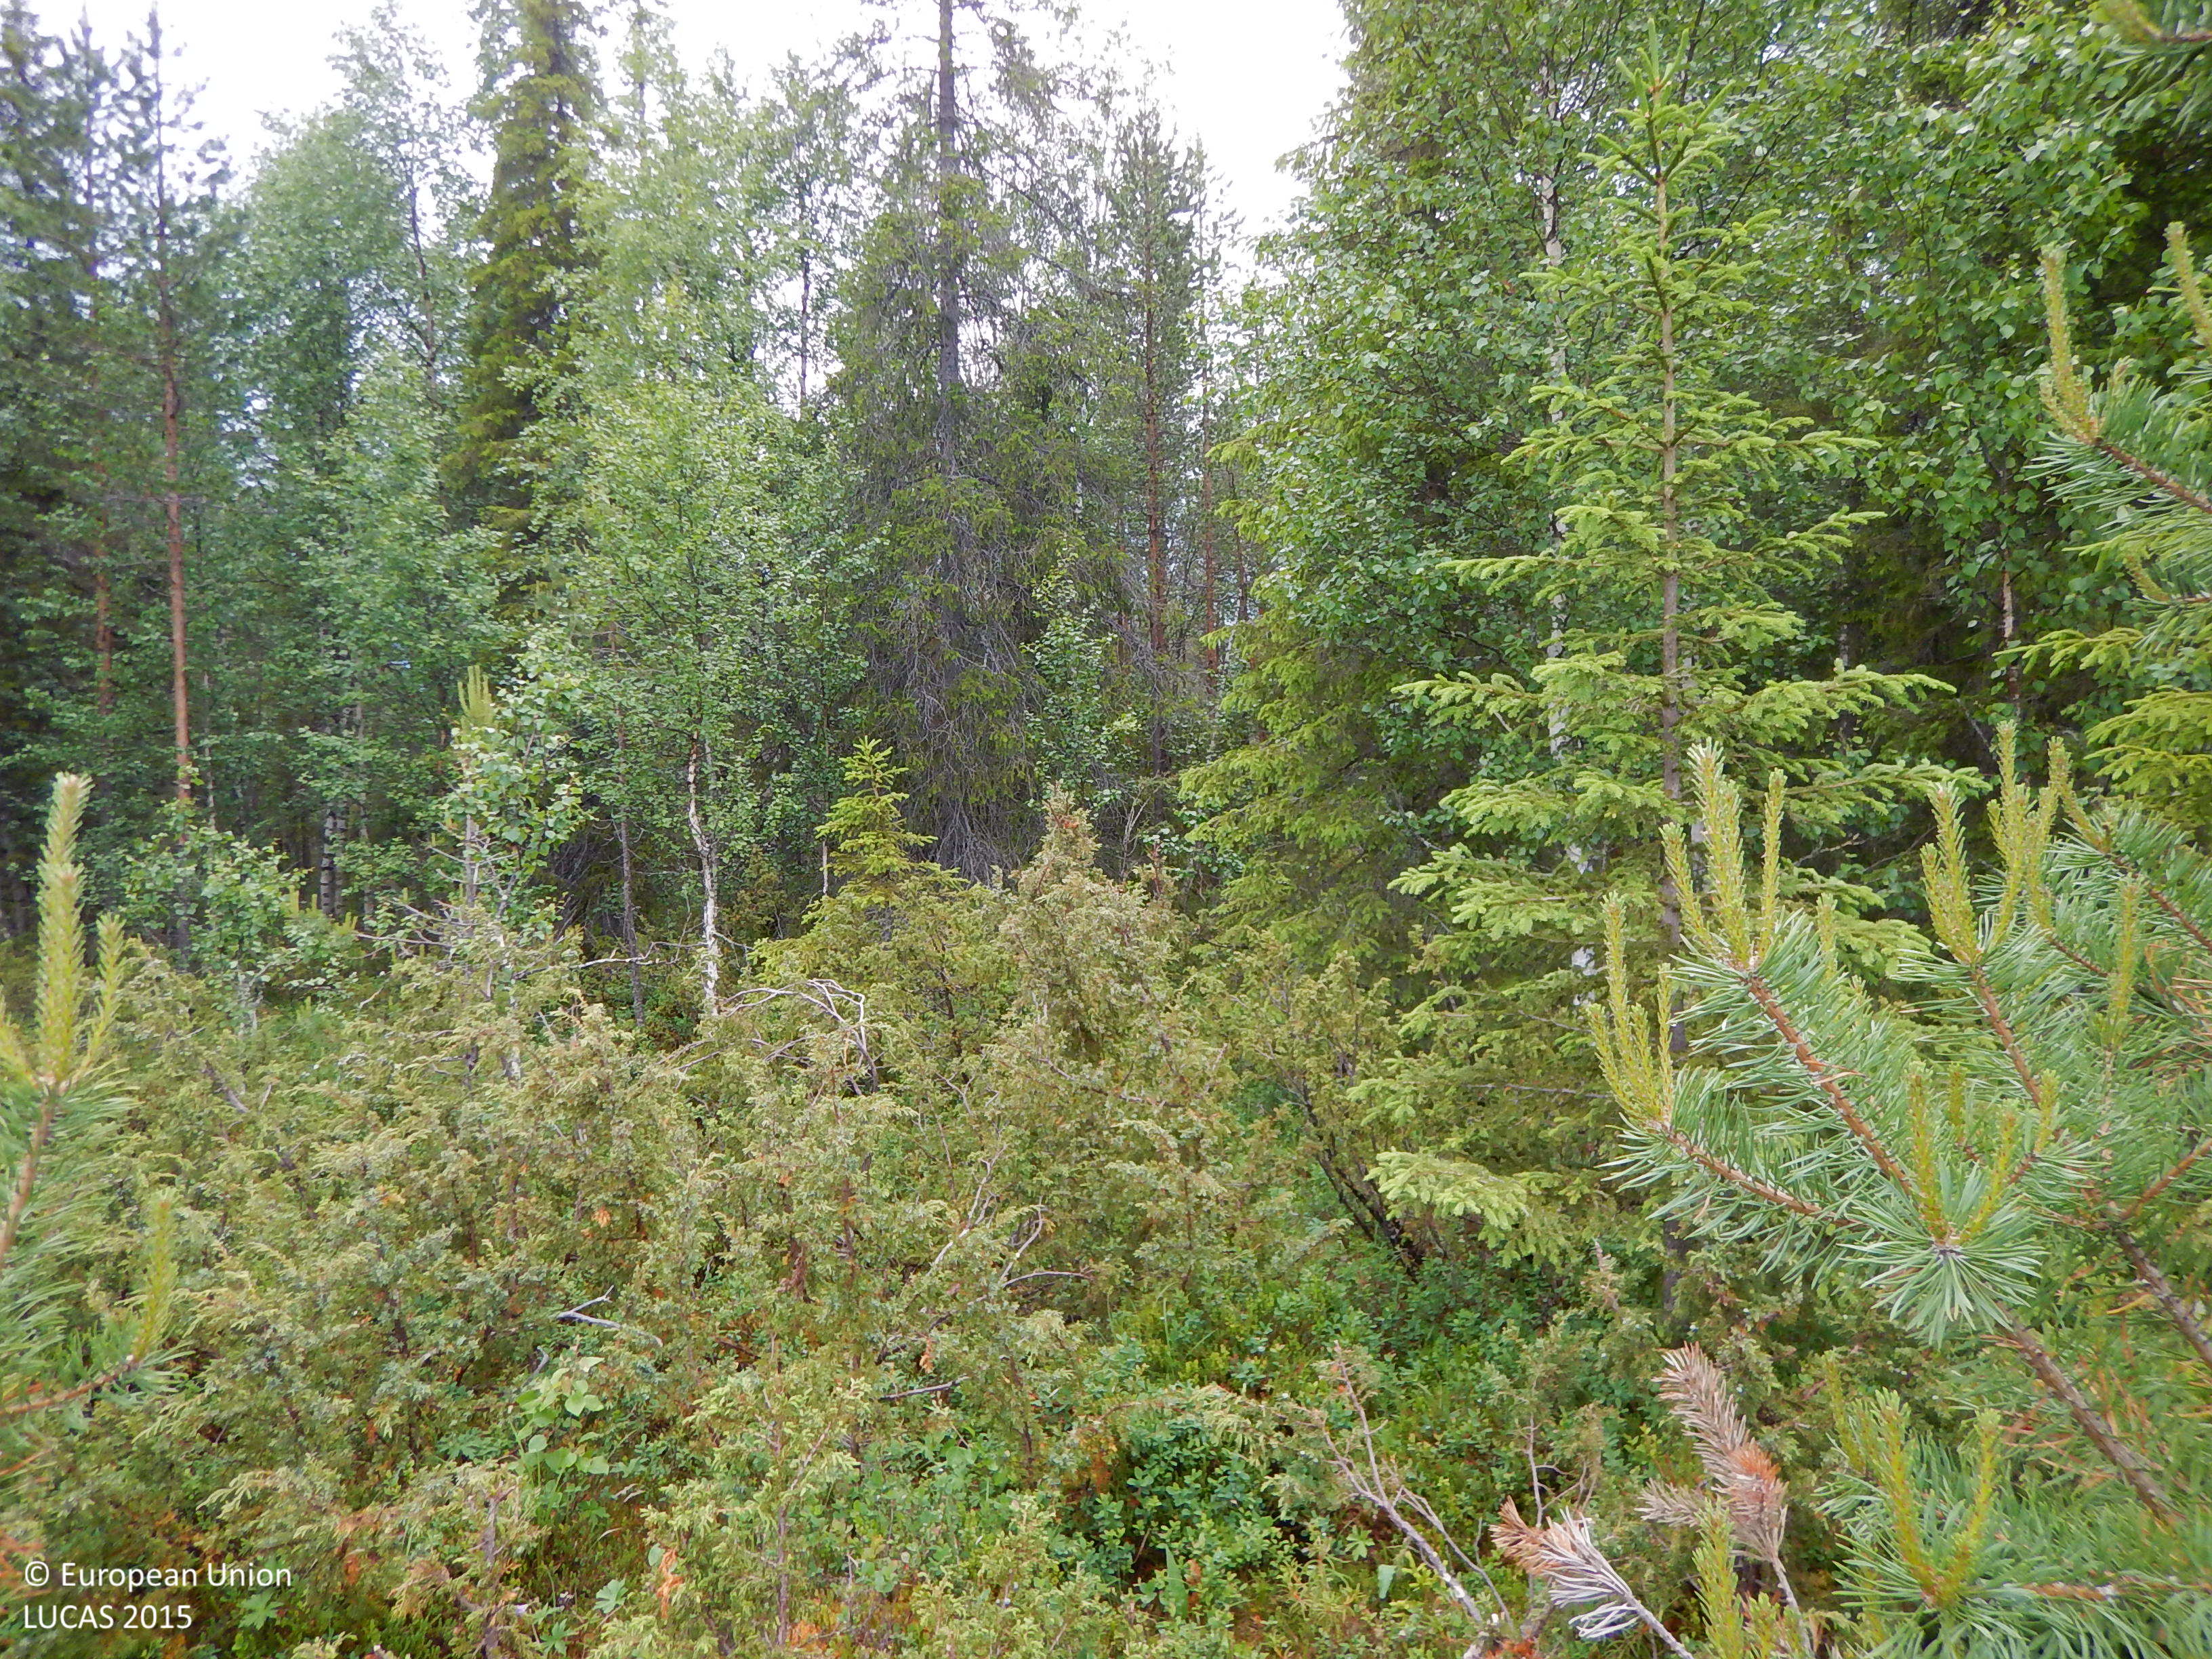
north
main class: Woodland
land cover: Pine dominated coniferous woodland
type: boreal forest
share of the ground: 10 - 25 %
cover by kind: herbaceous plants 45 %, coniferous forest trees 15 %, consolidated bare surface 15 %, shrubs 10 %, lichens and mosses 10 %, broadleaved forest trees 5 %
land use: Forestry
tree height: < 5 m
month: July
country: SE
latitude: 65.2554
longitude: 19.2778
